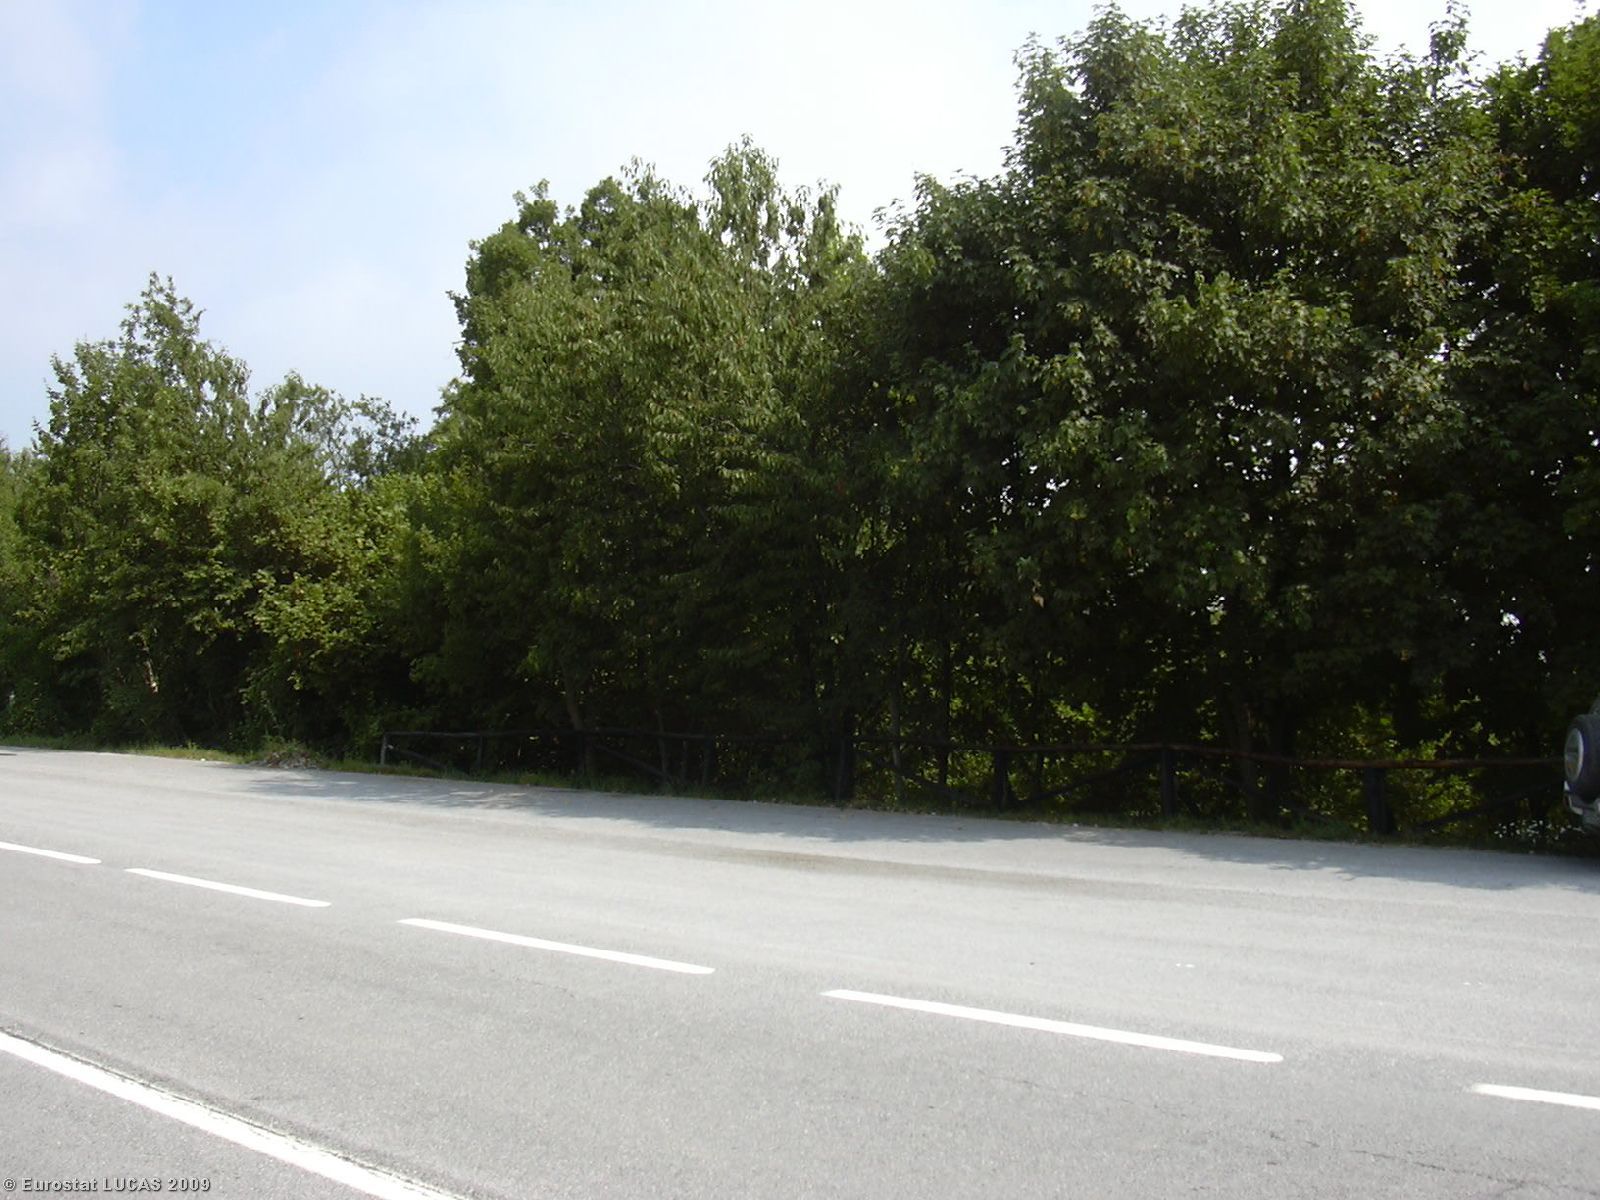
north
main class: Woodland
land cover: Broadleaved woodland
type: mesophytic deciduous forest
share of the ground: 10 - 25 %
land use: Unused
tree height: > 5 m
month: July
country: IT
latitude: 44.4055
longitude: 8.1081
